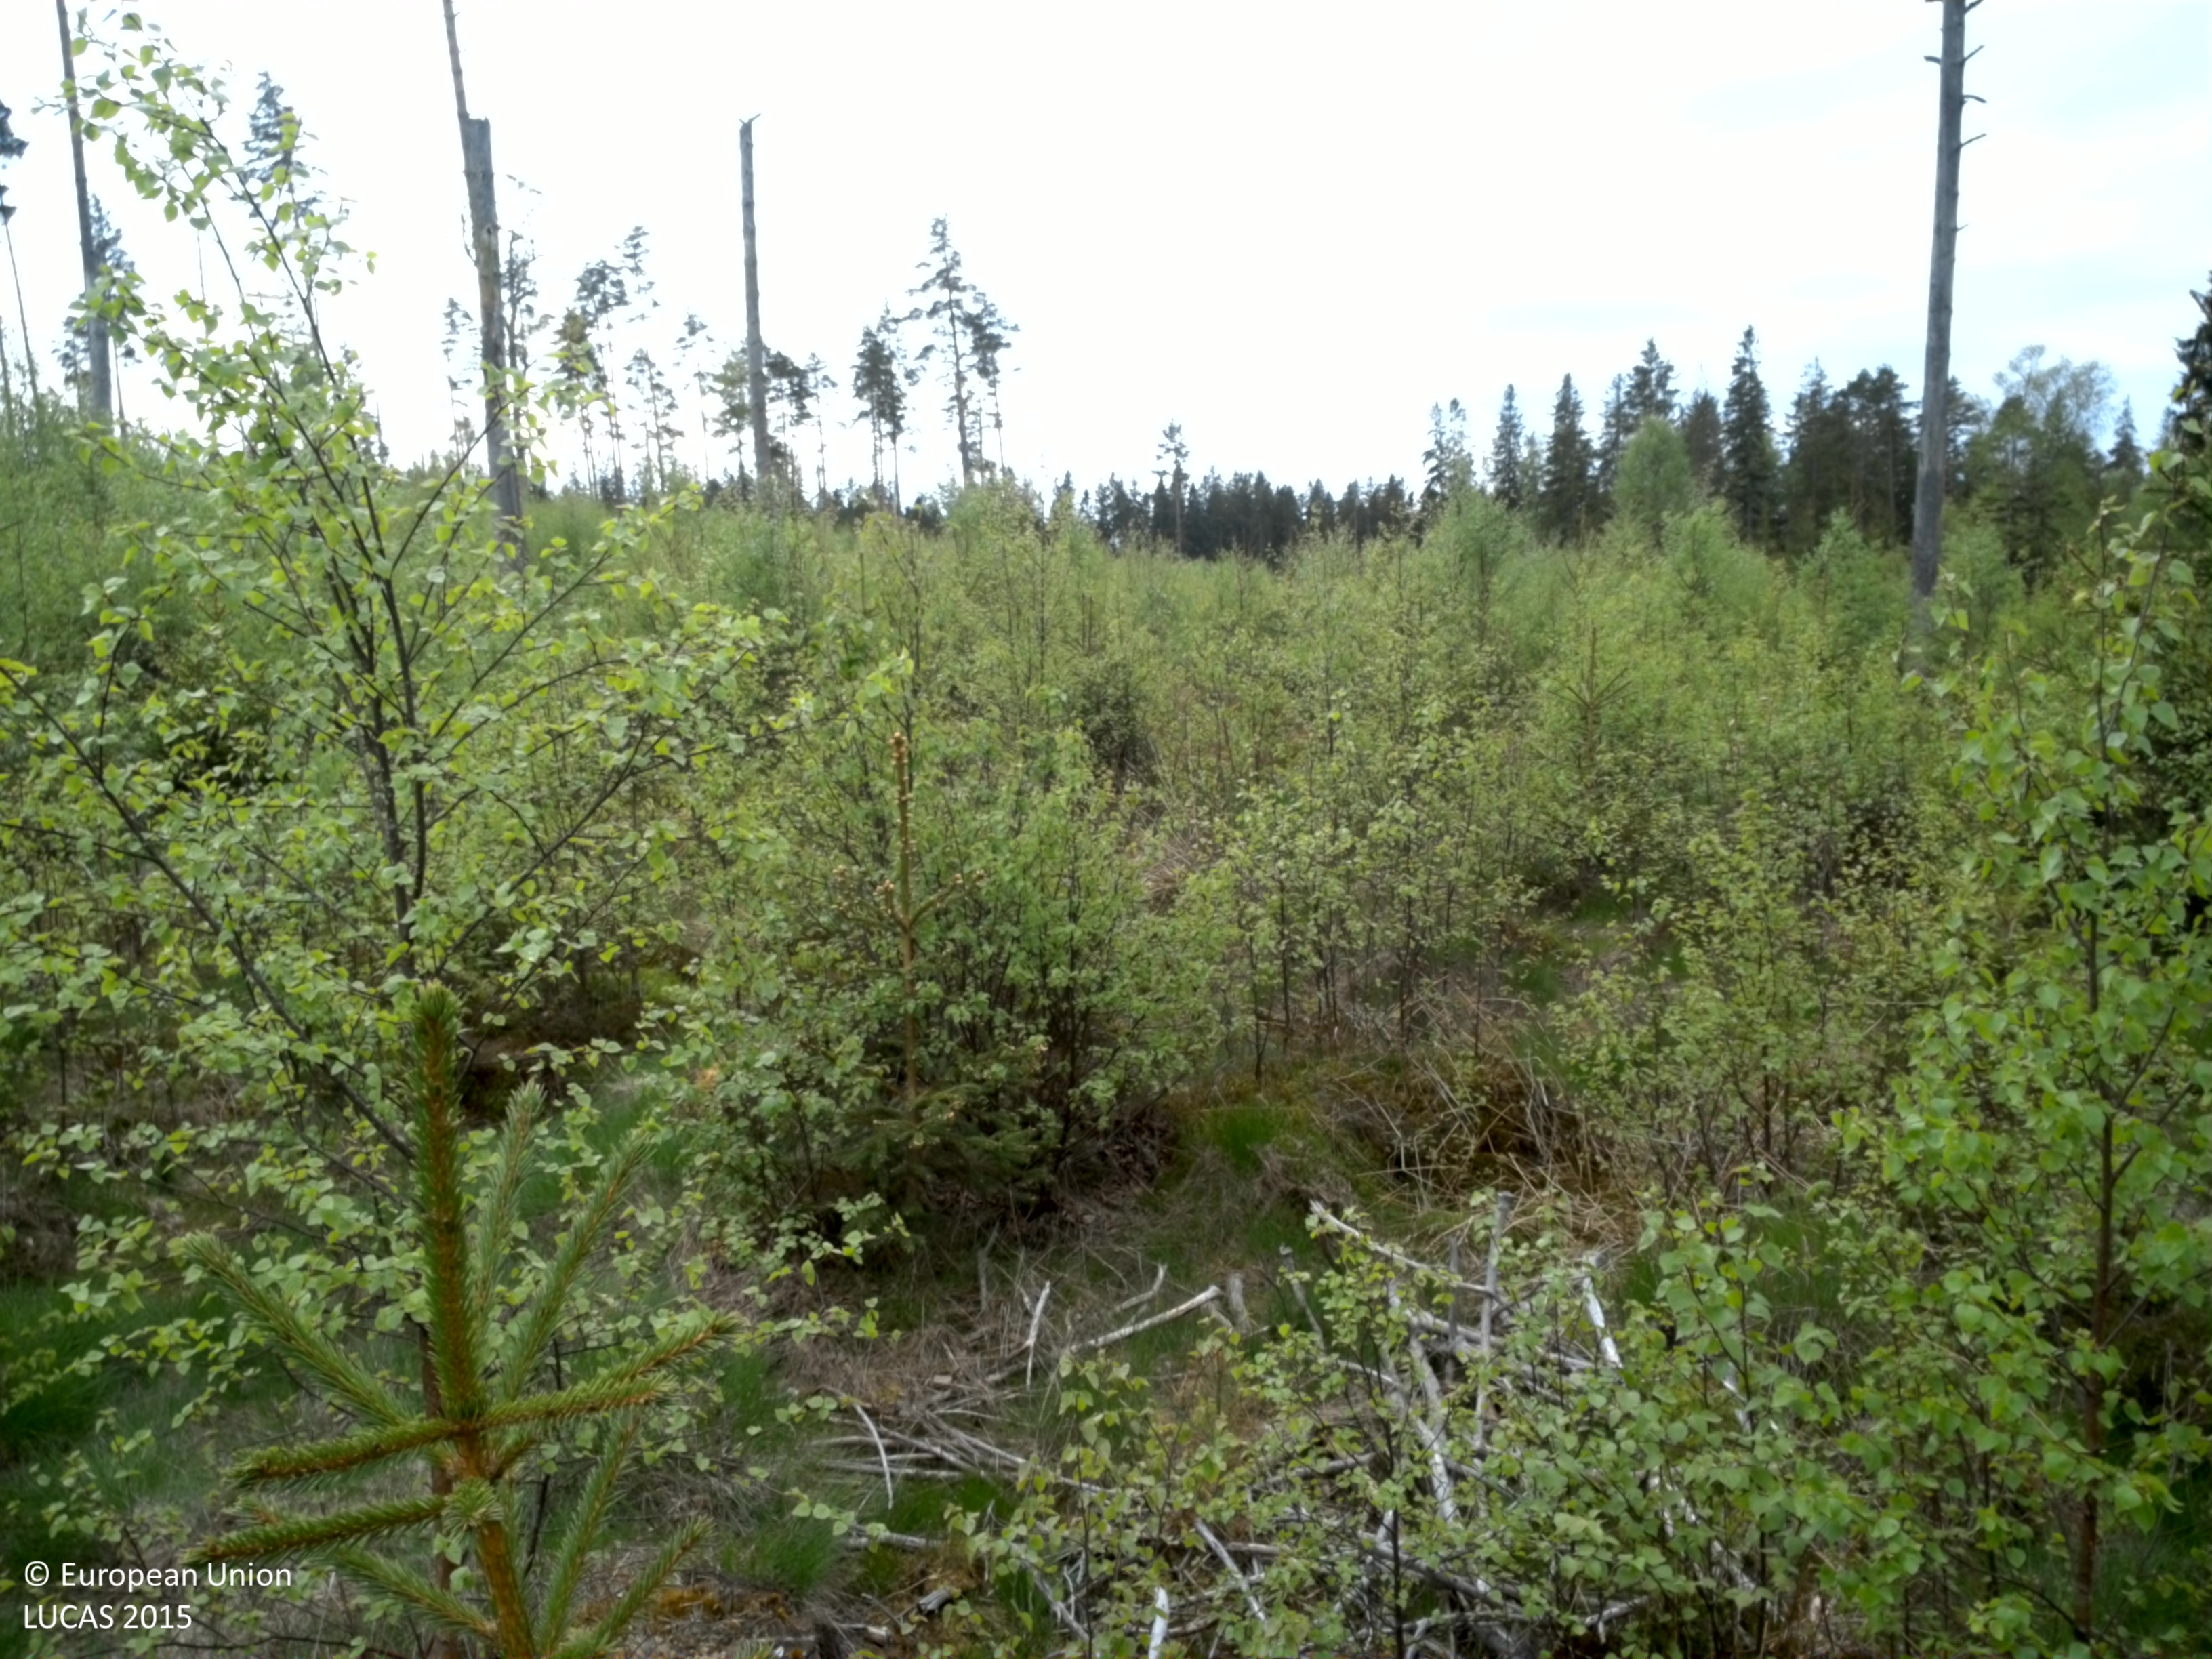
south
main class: Woodland
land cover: Spruce dominated mixed woodland
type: boreal forest
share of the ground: 50 - 75 %
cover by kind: broadleaved forest trees 40 %, coniferous forest trees 35 %, shrubs 10 %, herbaceous plants 10 %, lichens and mosses 5 %
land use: Forestry
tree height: < 5 m
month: May
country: SE
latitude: 56.9099
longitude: 15.2366
